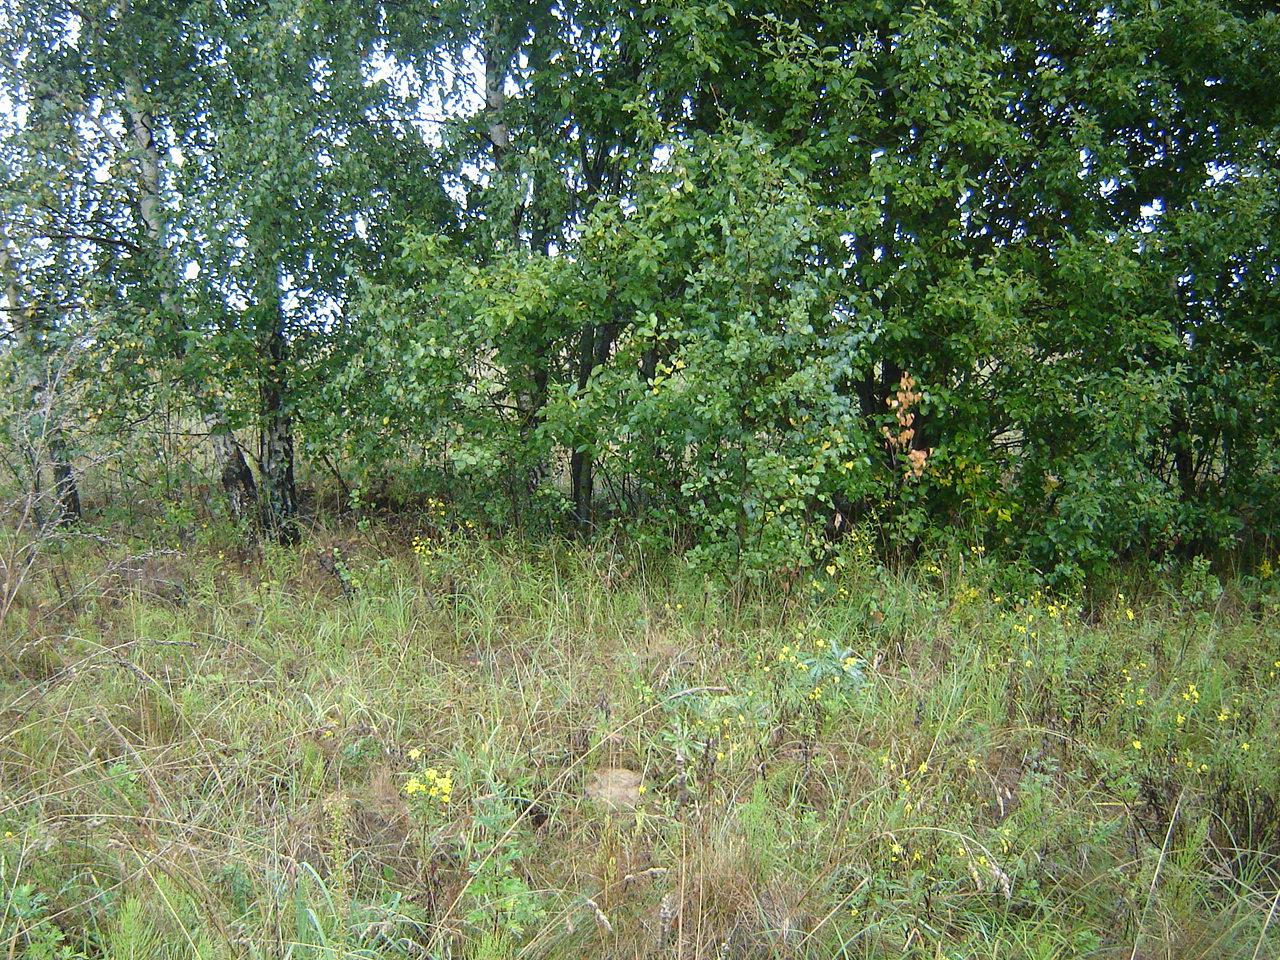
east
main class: Grassland
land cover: Spontaneously vegetated surfaces
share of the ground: > 75 %
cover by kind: herbaceous plants 100 %
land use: Fallow land
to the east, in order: Spontaneously vegetated surfaces; Broadleaved woodland; Spontaneously vegetated surfaces; Broadleaved woodland; Spontaneously vegetated surfaces; Grassland without tree/shrub cover; Electric lines; Grassland without tree/shrub cover; Spontaneously vegetated surfaces
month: September
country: LT
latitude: 55.0189
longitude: 25.3399
